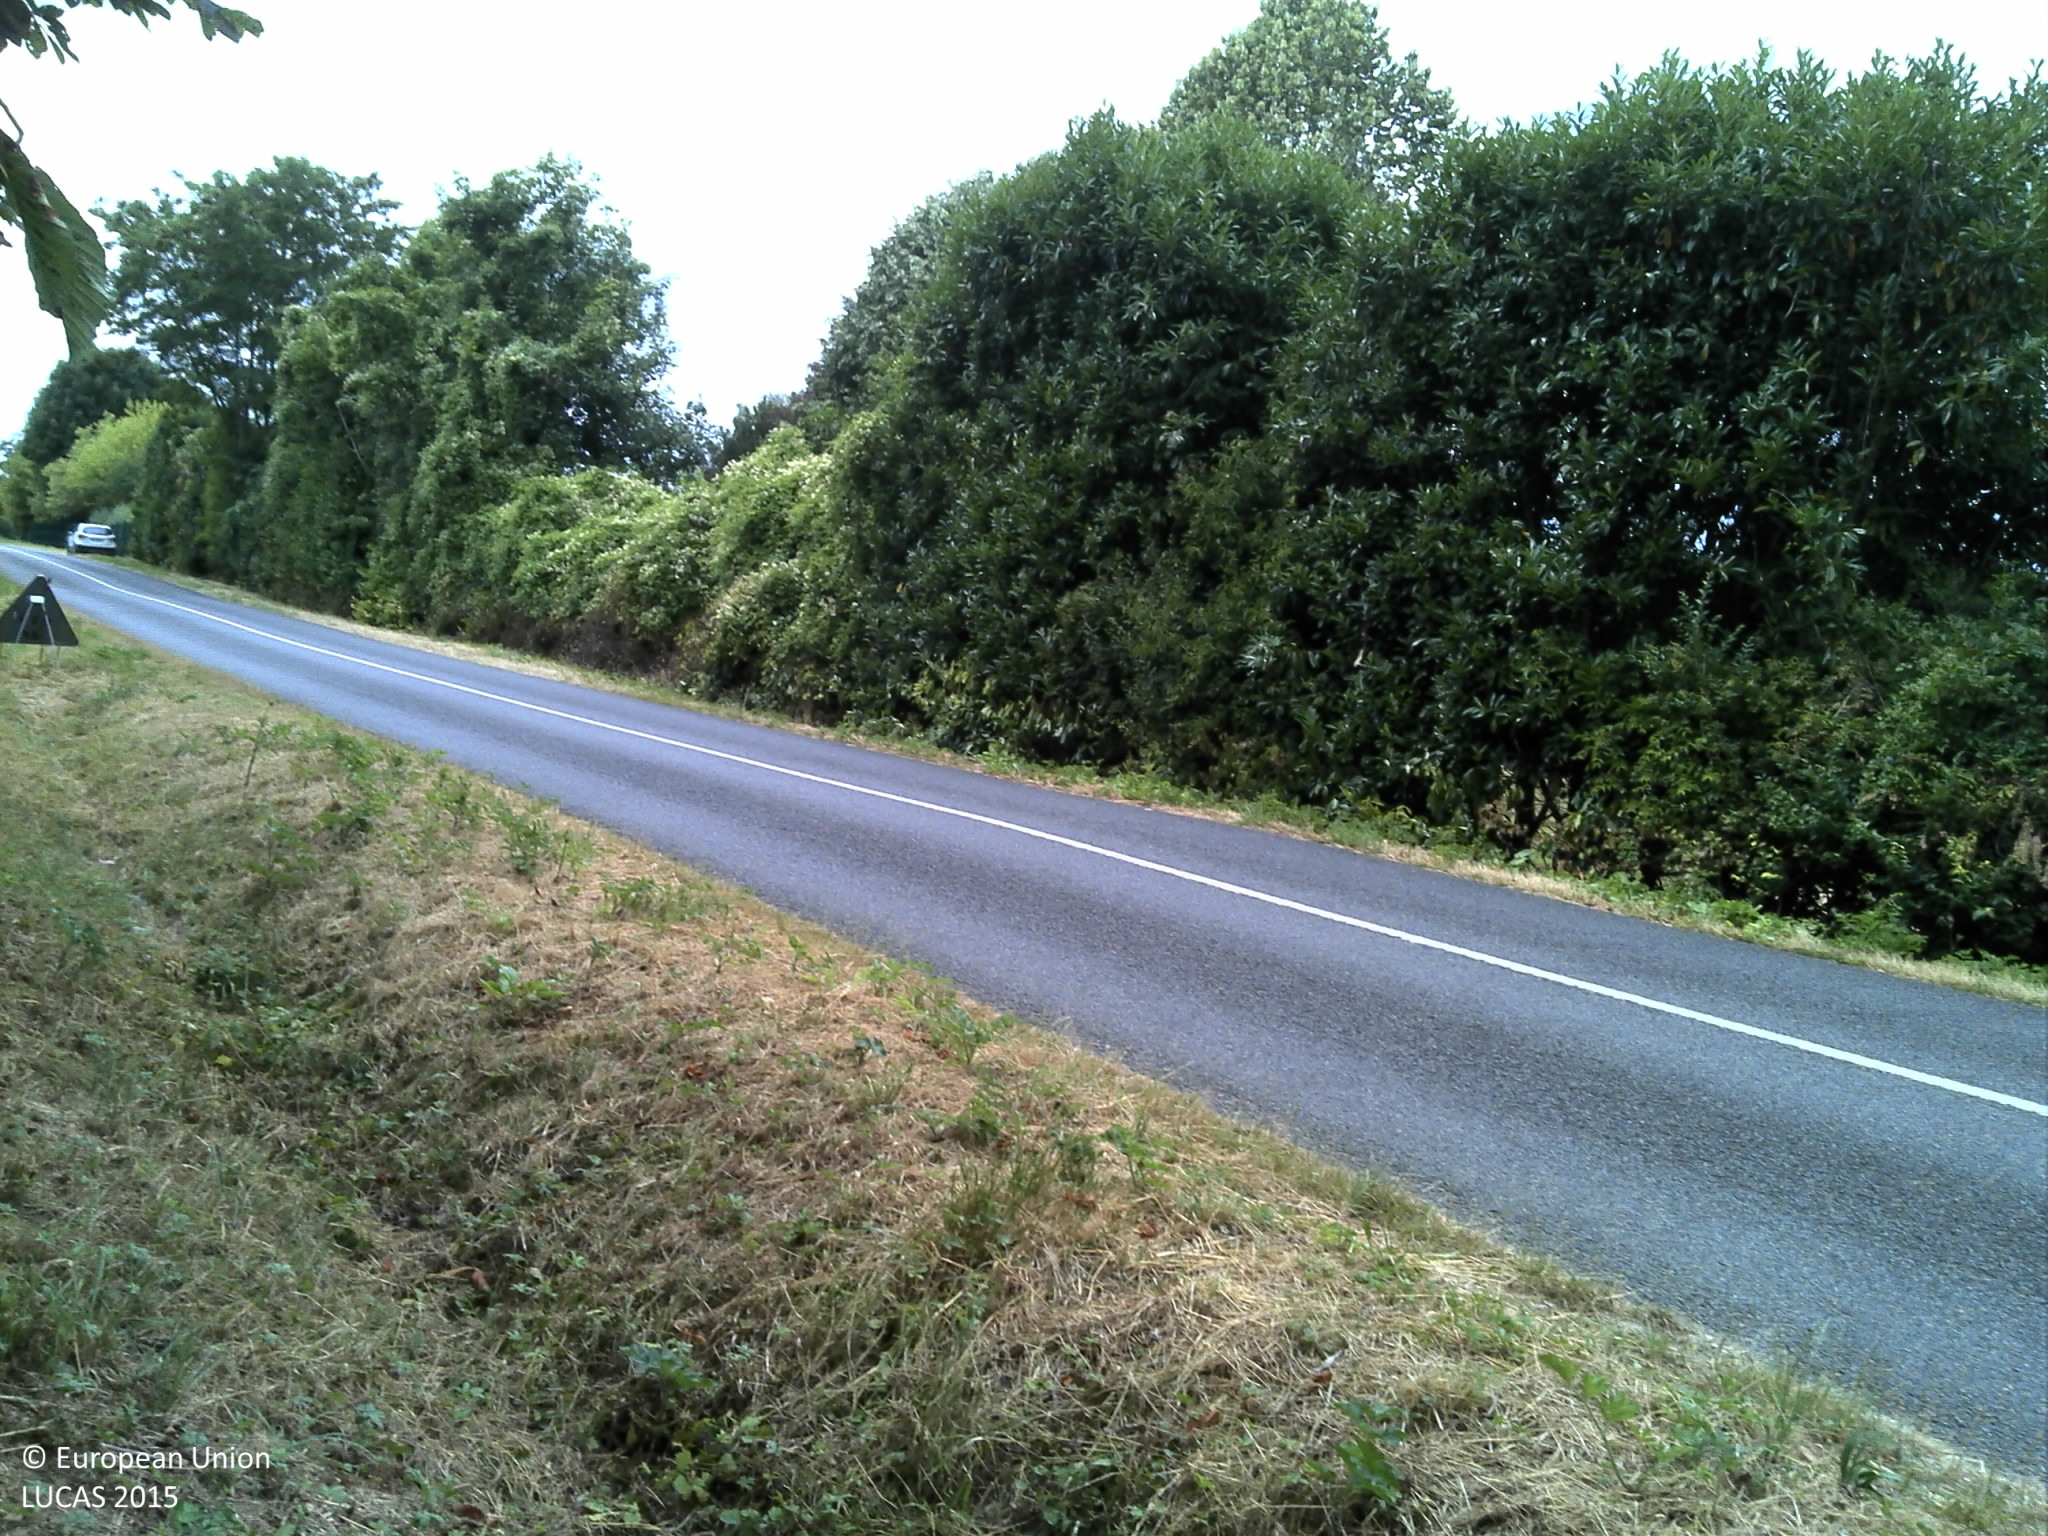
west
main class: Woodland
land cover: Broadleaved woodland
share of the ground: > 75 %
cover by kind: broadleaved forest trees 50 %, herbaceous plants 35 %, consolidated bare surface 15 %
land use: Sport
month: July
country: FR
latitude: 48.6354
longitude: 2.4849
